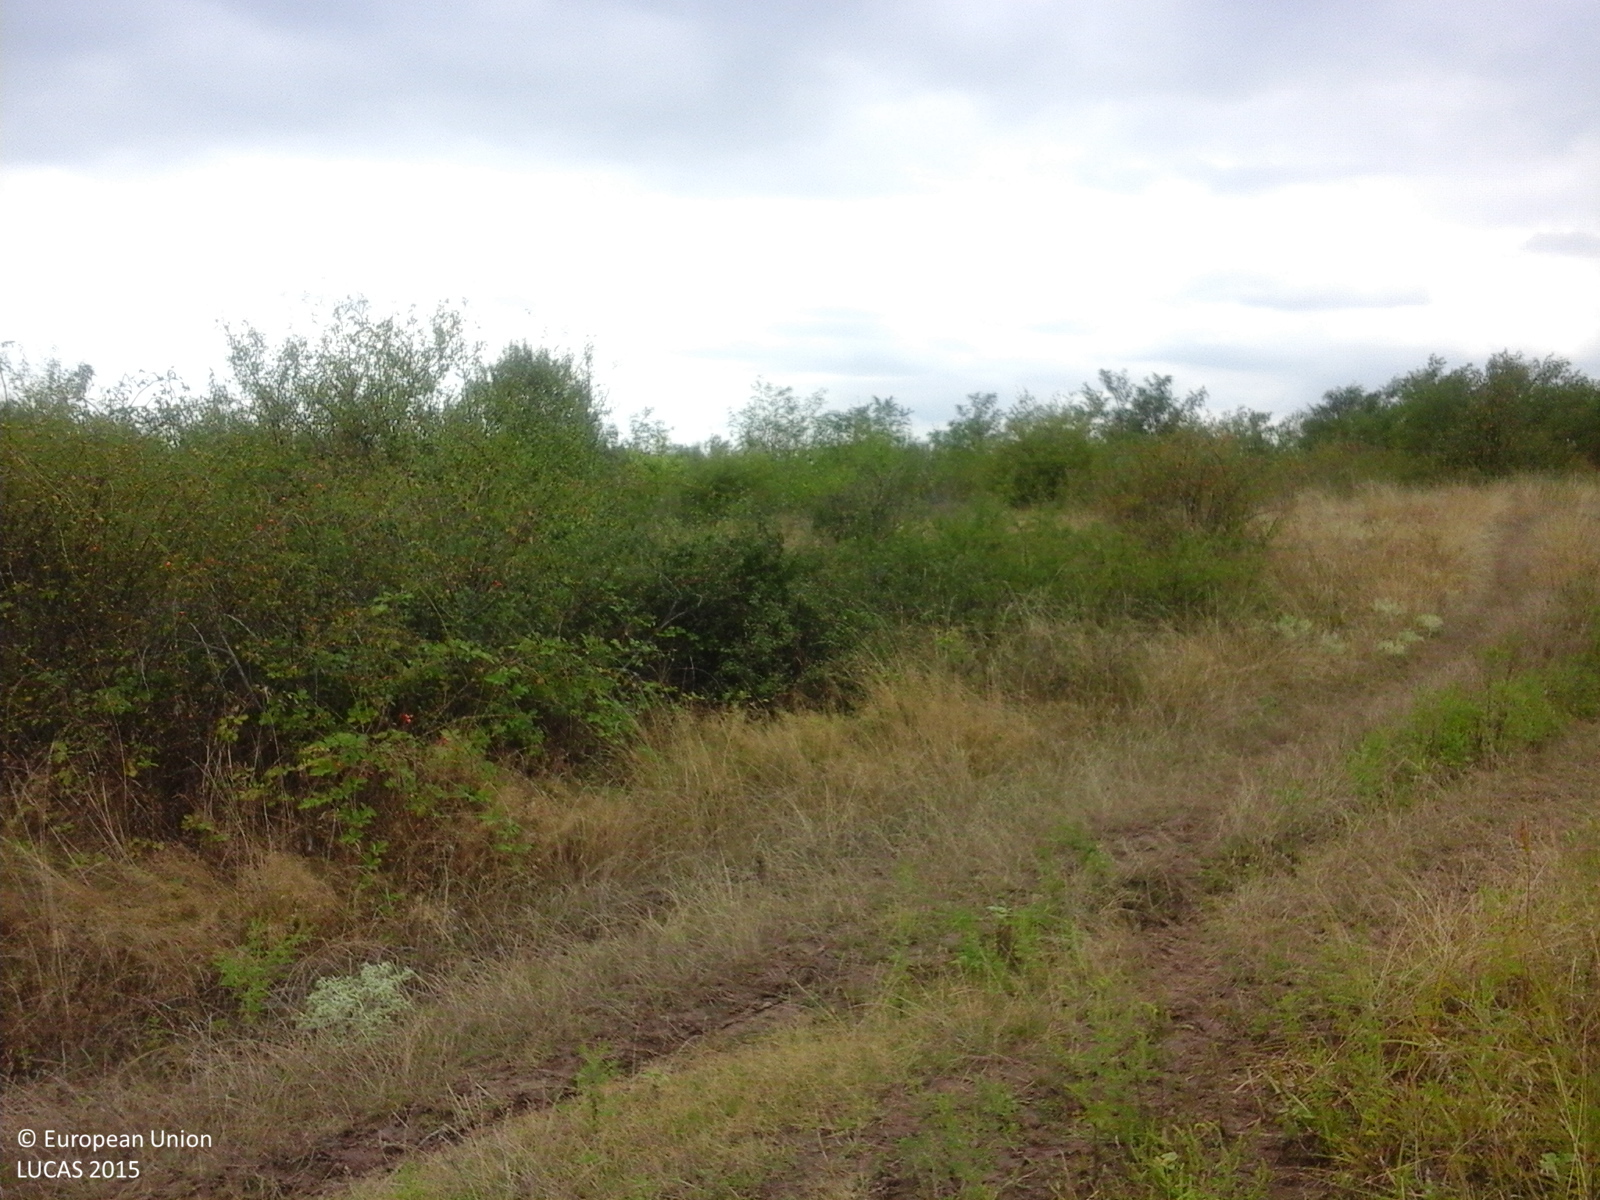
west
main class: Grassland
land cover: Spontaneously vegetated surfaces
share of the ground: > 75 %
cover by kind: herbaceous plants 100 %
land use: Agriculture (excluding fallow land and kitchen gardens)
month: August
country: RO
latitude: 45.5277
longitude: 21.6733
